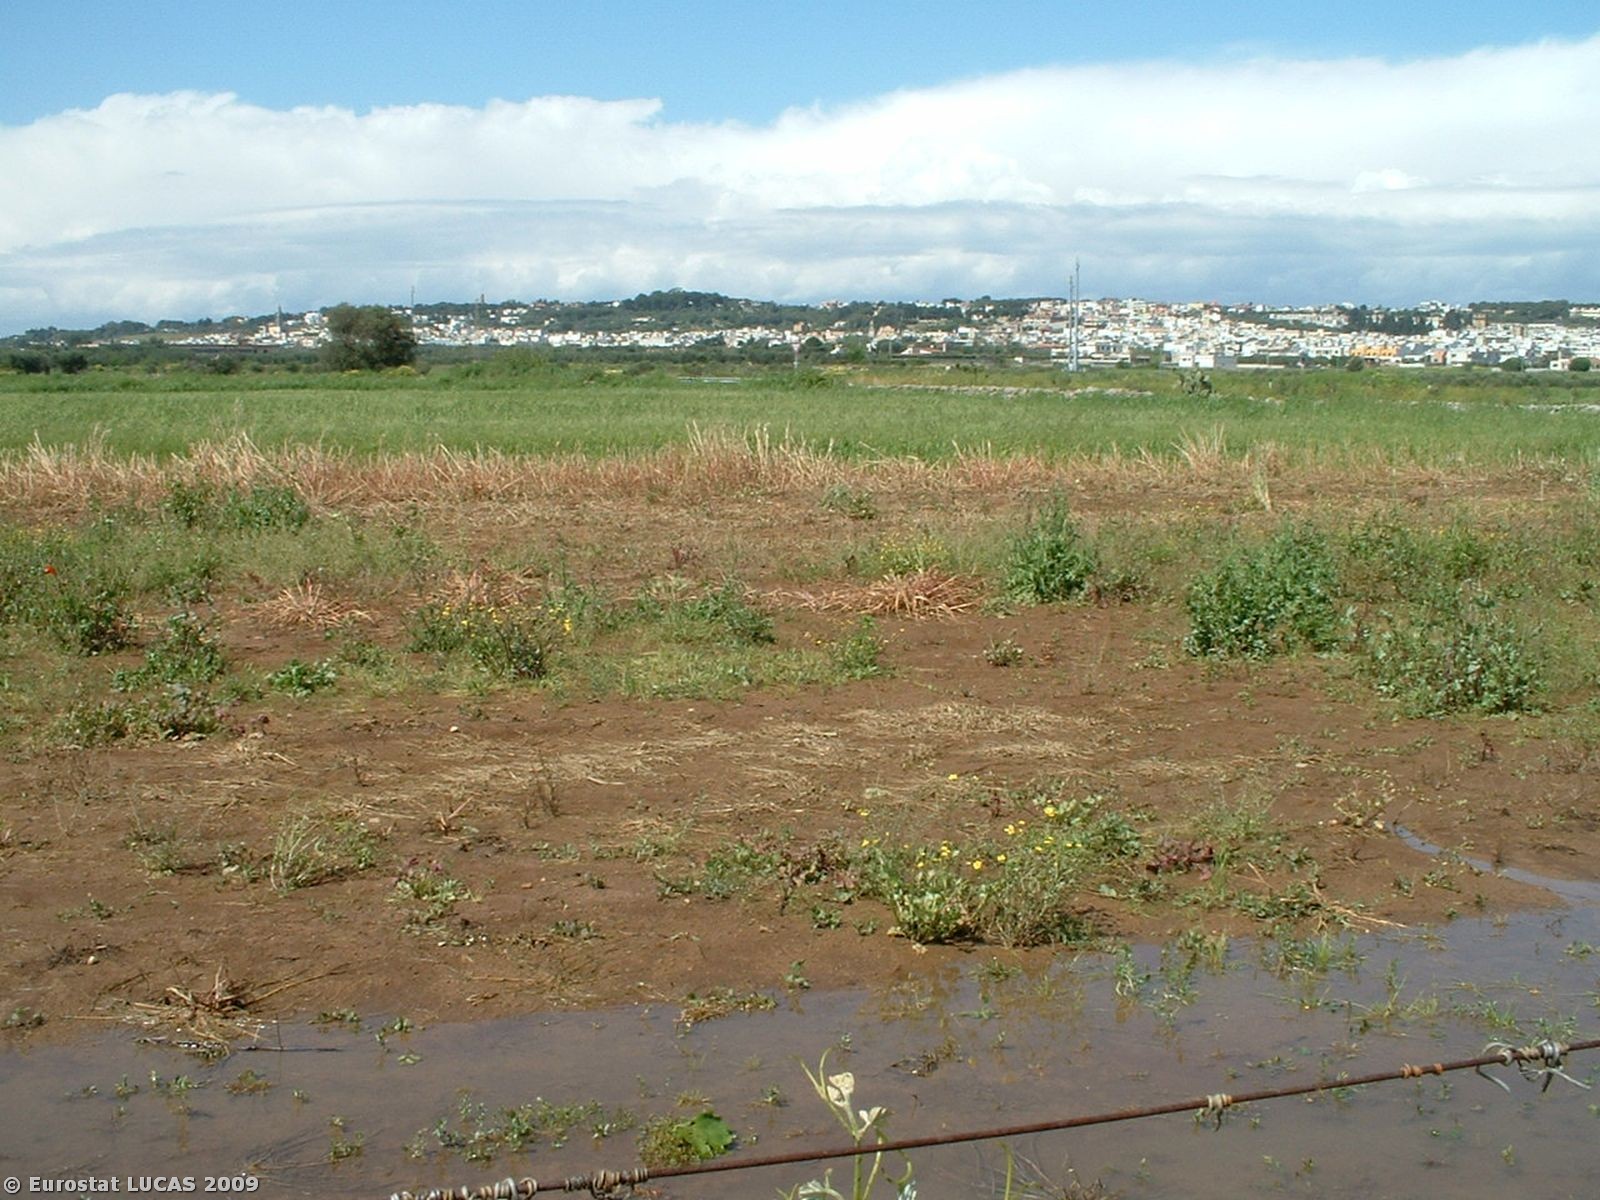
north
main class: Cropland
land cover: Vineyards
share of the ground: 50 - 75 %
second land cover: Bare land
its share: > 75 %
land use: Agriculture (excluding fallow land and kitchen gardens)
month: April
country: IT
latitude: 40.0594
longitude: 18.0975
